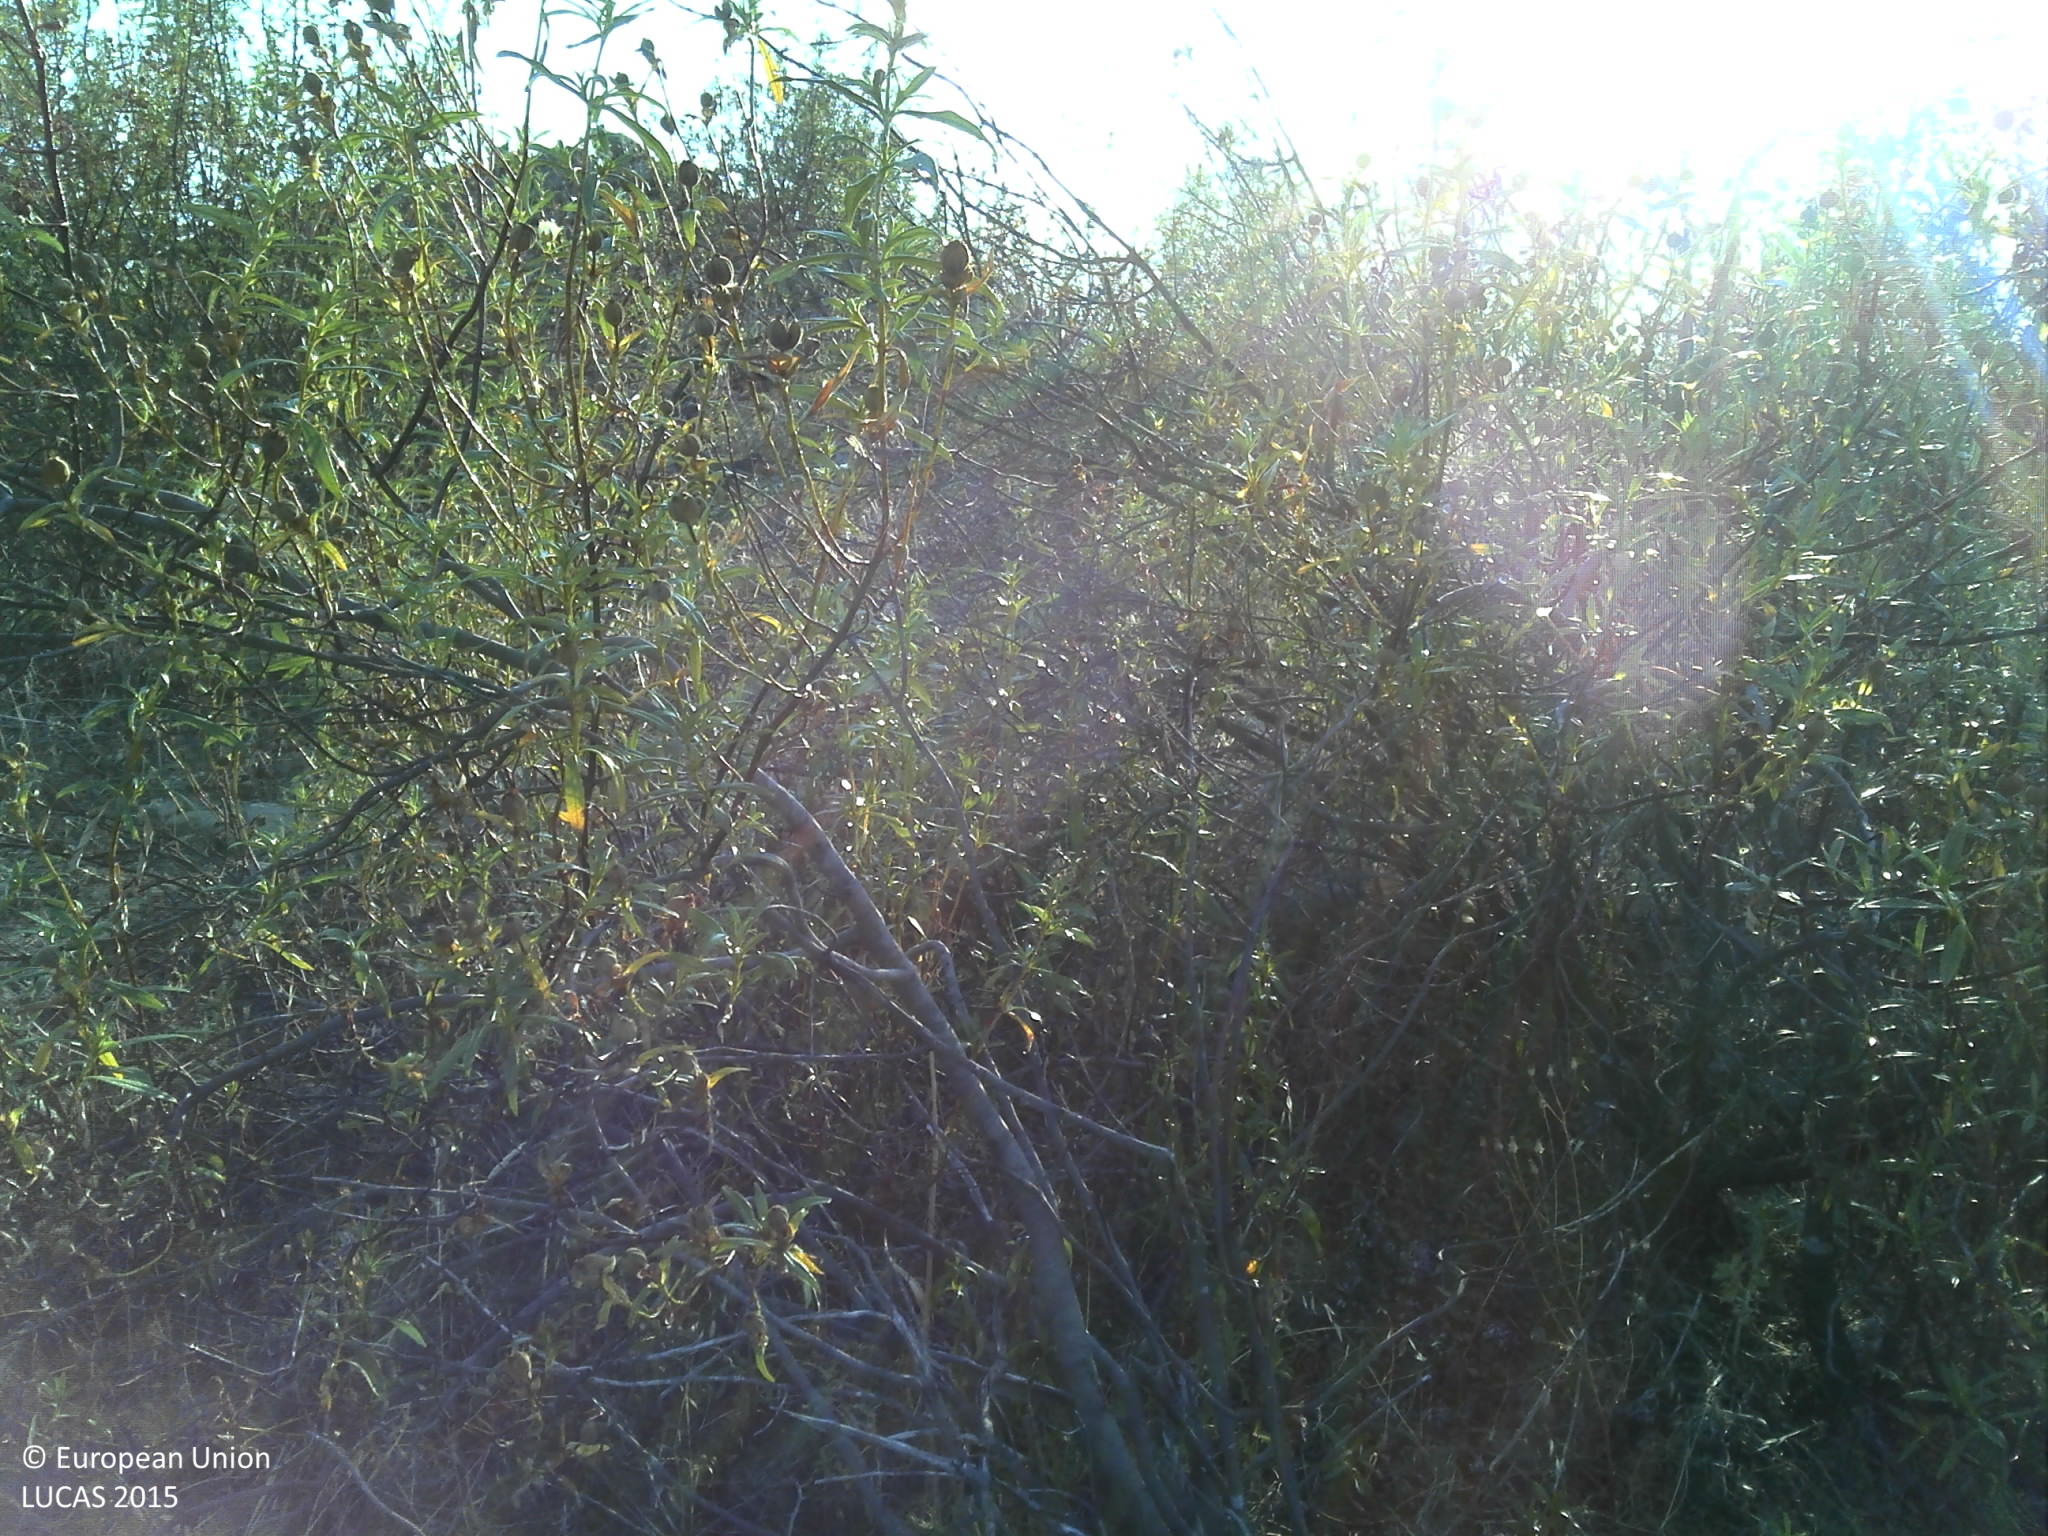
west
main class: Shrubland
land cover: Shrubland without tree cover
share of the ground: > 75 %
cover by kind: shrubs 100 %
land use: Agriculture (excluding fallow land and kitchen gardens)
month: June
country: PT
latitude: 37.5139
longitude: -7.9053
